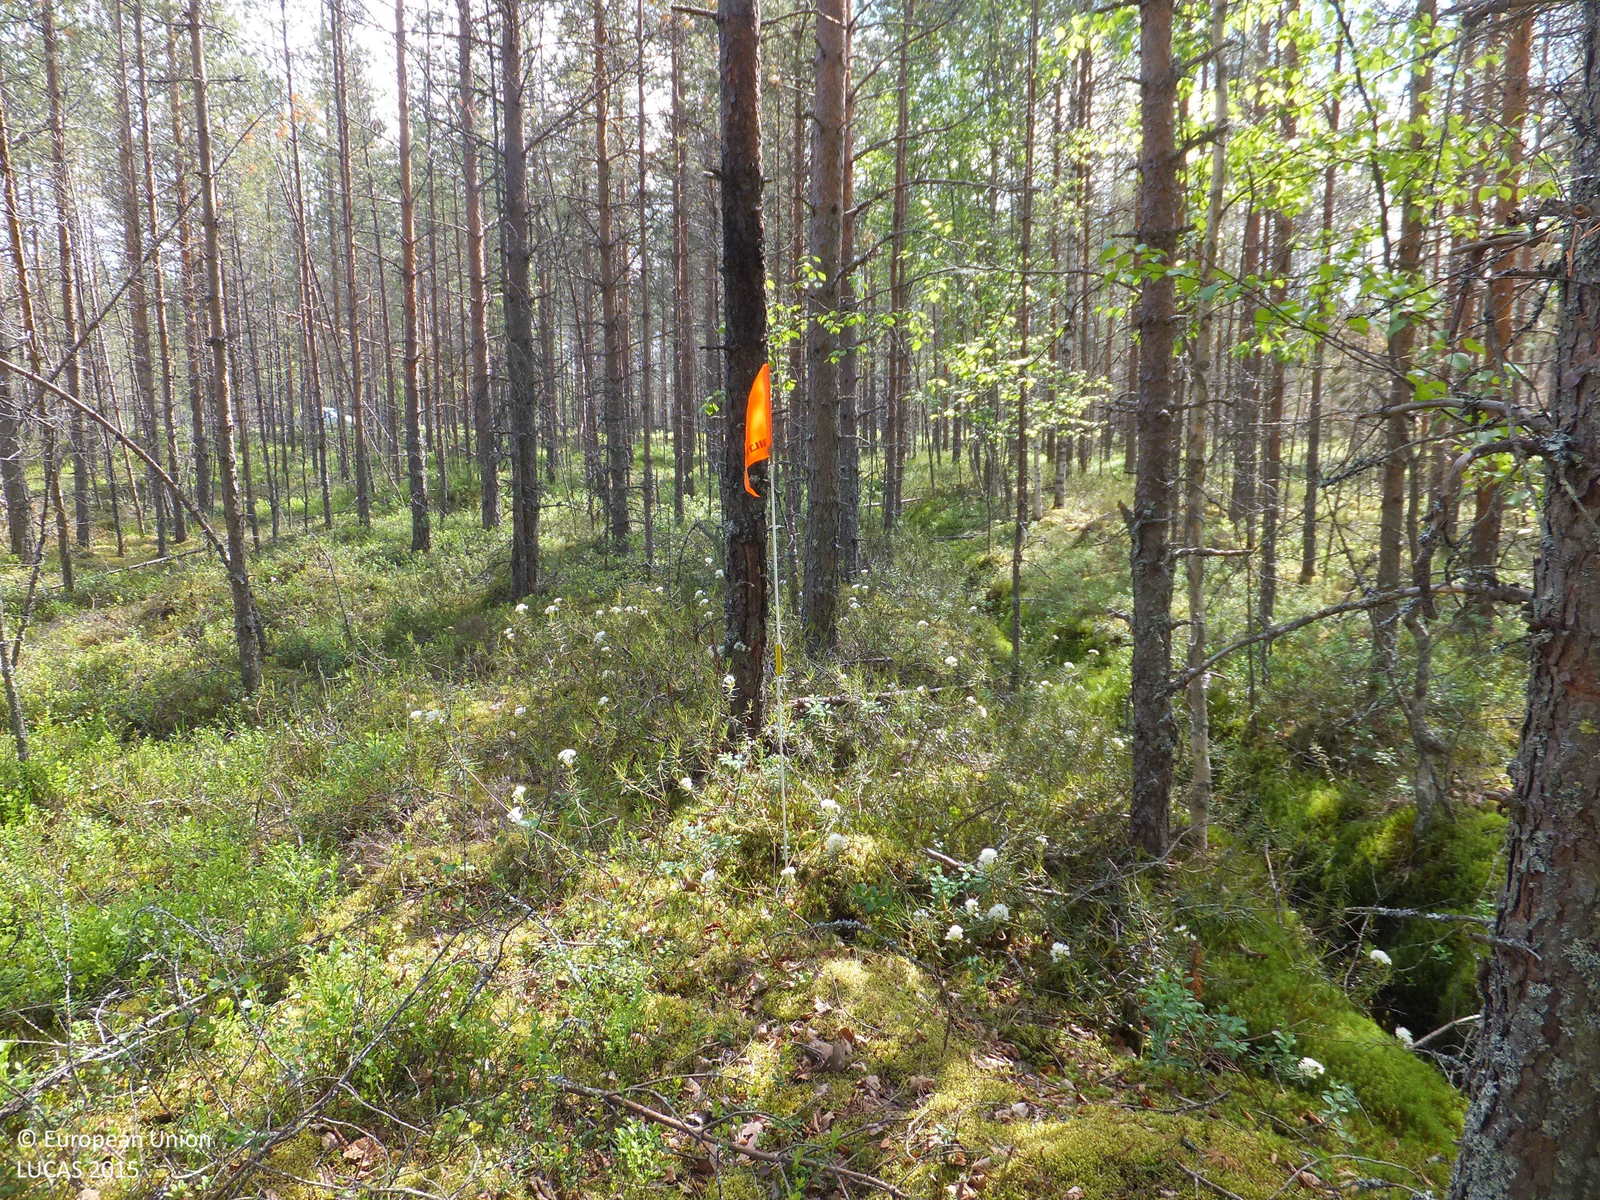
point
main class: Woodland
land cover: Pine dominated coniferous woodland
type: boreal forest
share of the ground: > 75 %
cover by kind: coniferous forest trees 75 %, shrubs 10 %, lichens and mosses 10 %, broadleaved forest trees 5 %
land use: Forestry
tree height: > 5 m
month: June
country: FI
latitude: 63.3354
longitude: 24.3596
